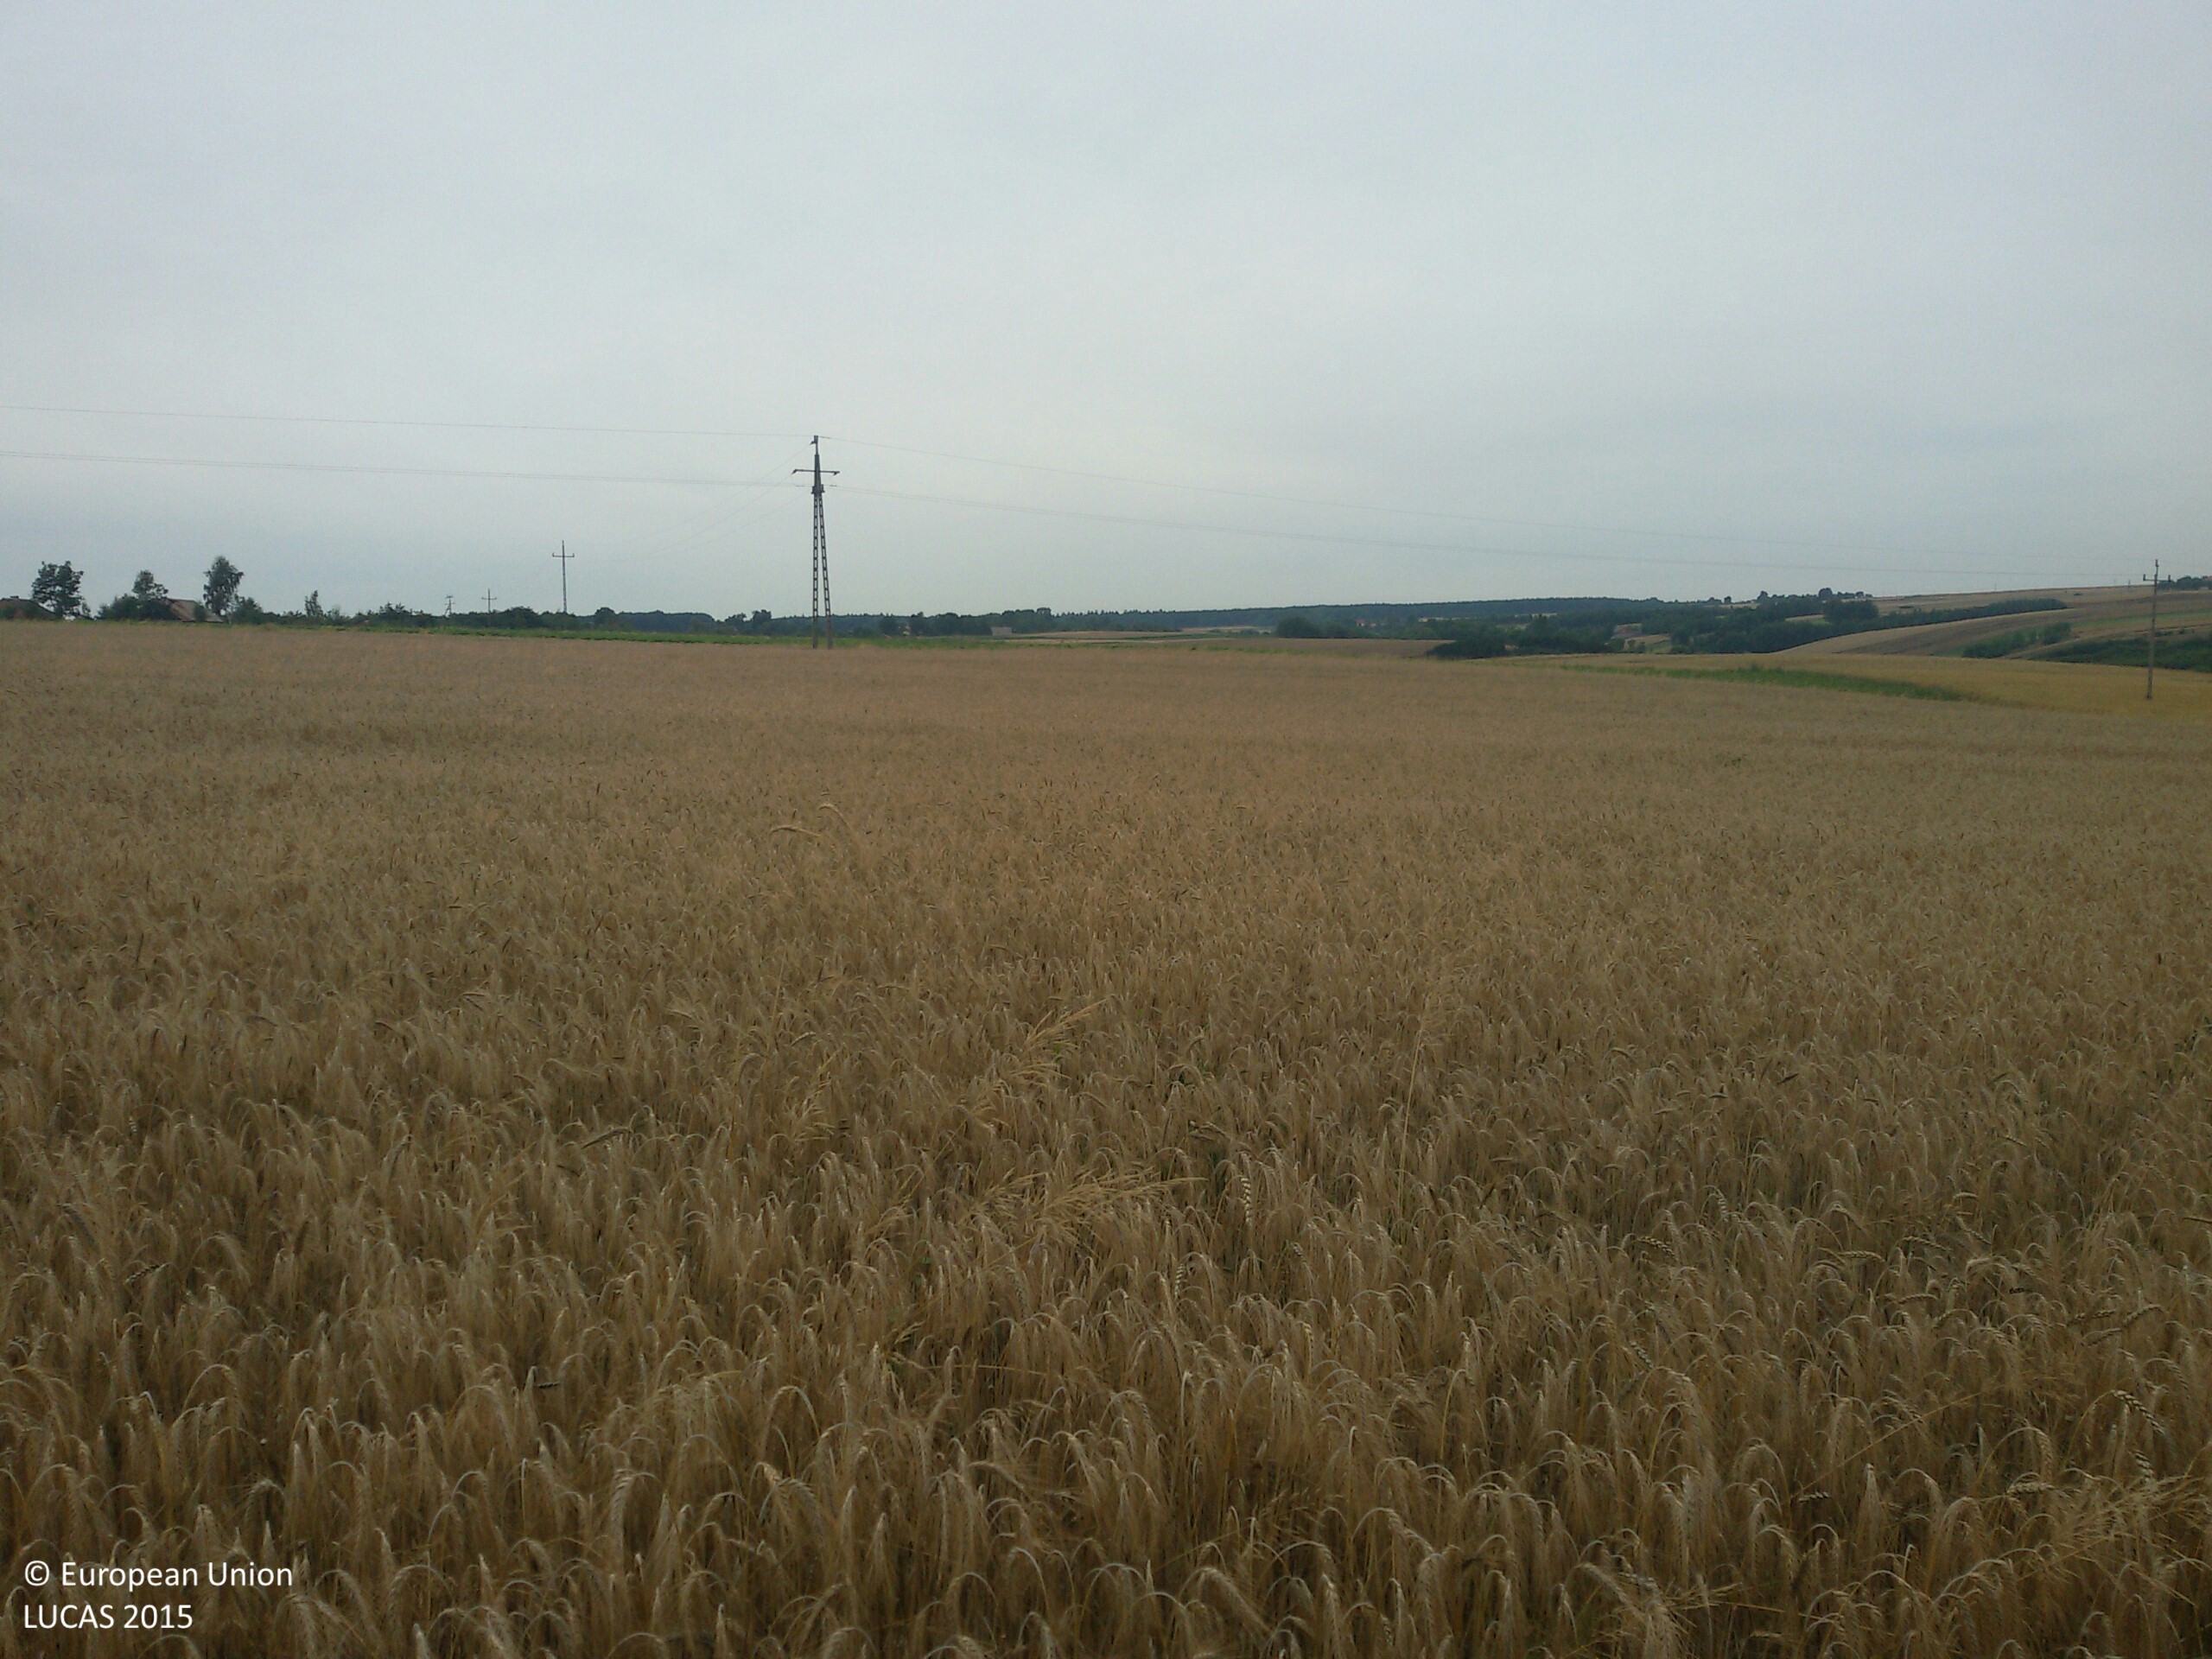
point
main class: Cropland
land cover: Triticale
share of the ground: > 75 %
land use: Agriculture (excluding fallow land and kitchen gardens)
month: July
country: PL
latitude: 50.4391
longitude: 20.3286
